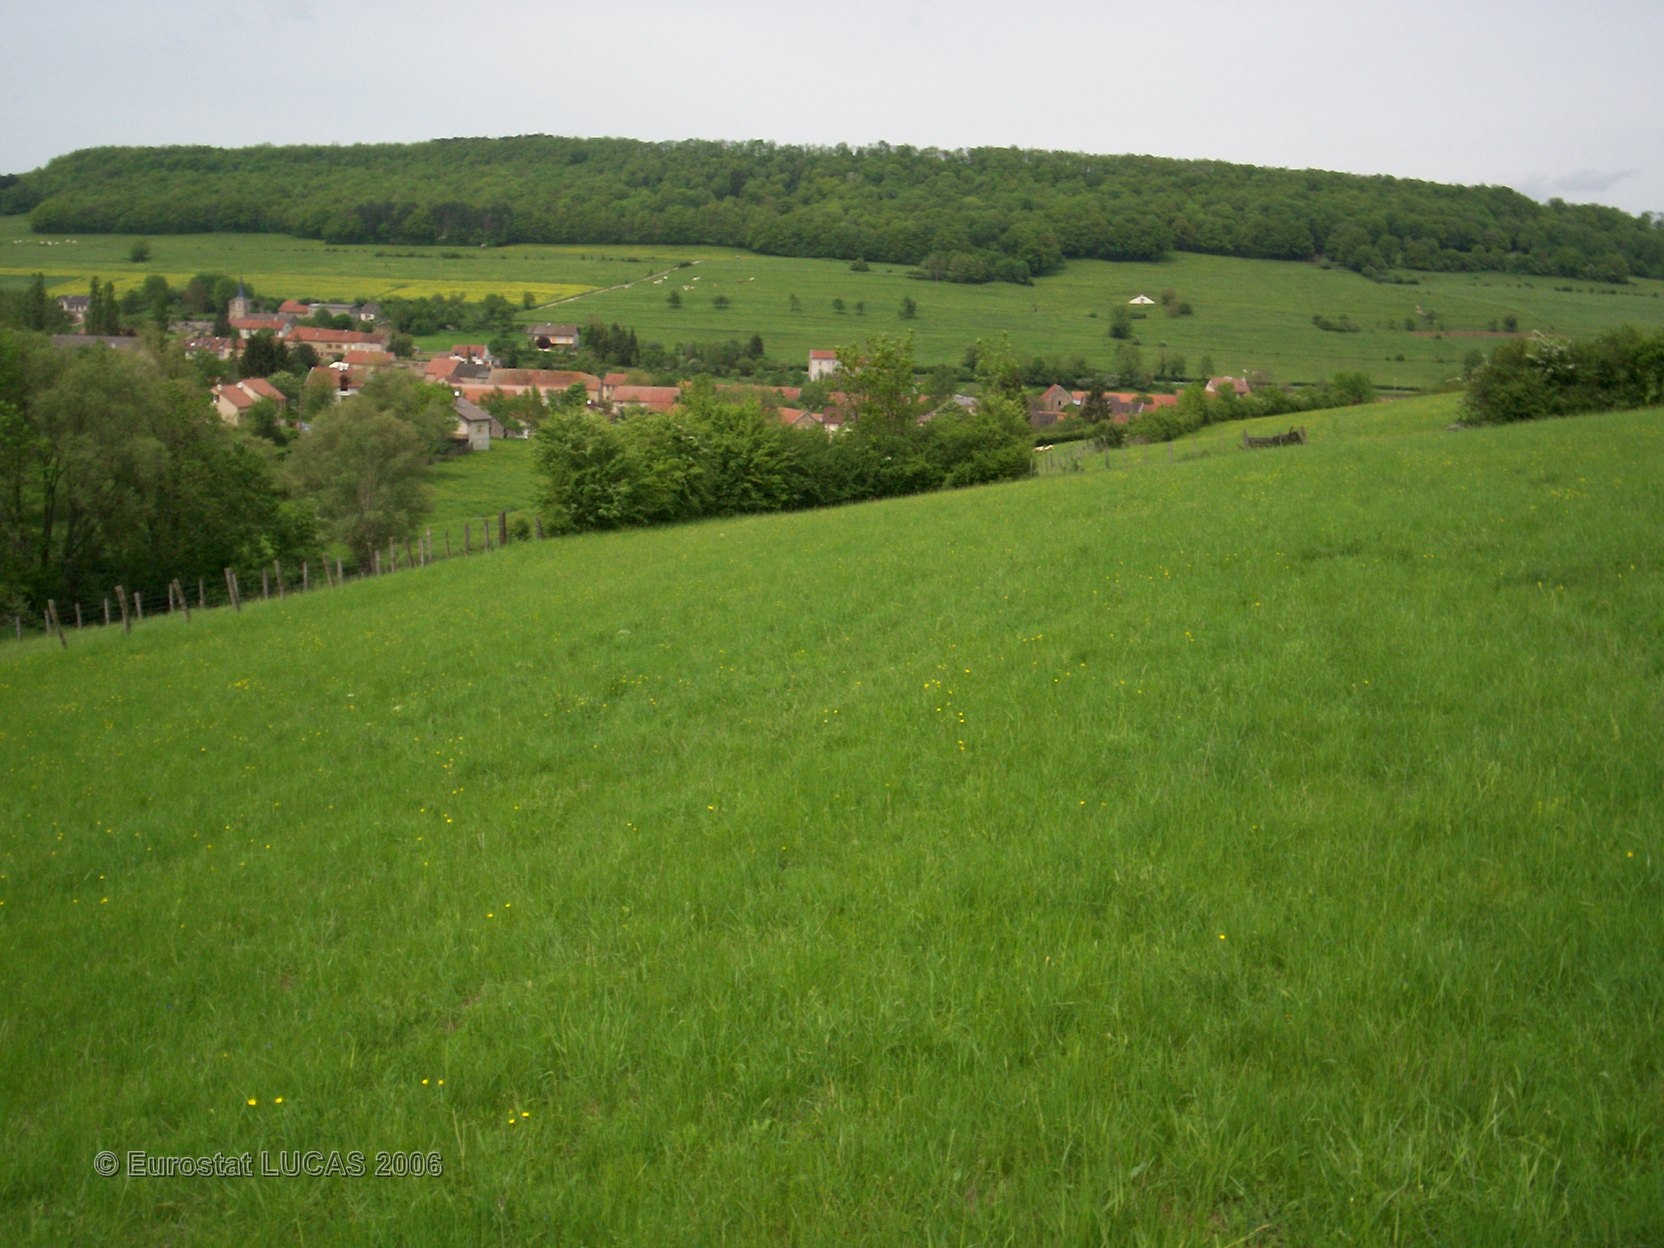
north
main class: Grassland
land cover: Grassland without tree/shrub cover
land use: Agriculture (excluding fallow land and kitchen gardens)
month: May
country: FR
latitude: 47.2997
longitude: 4.6436
